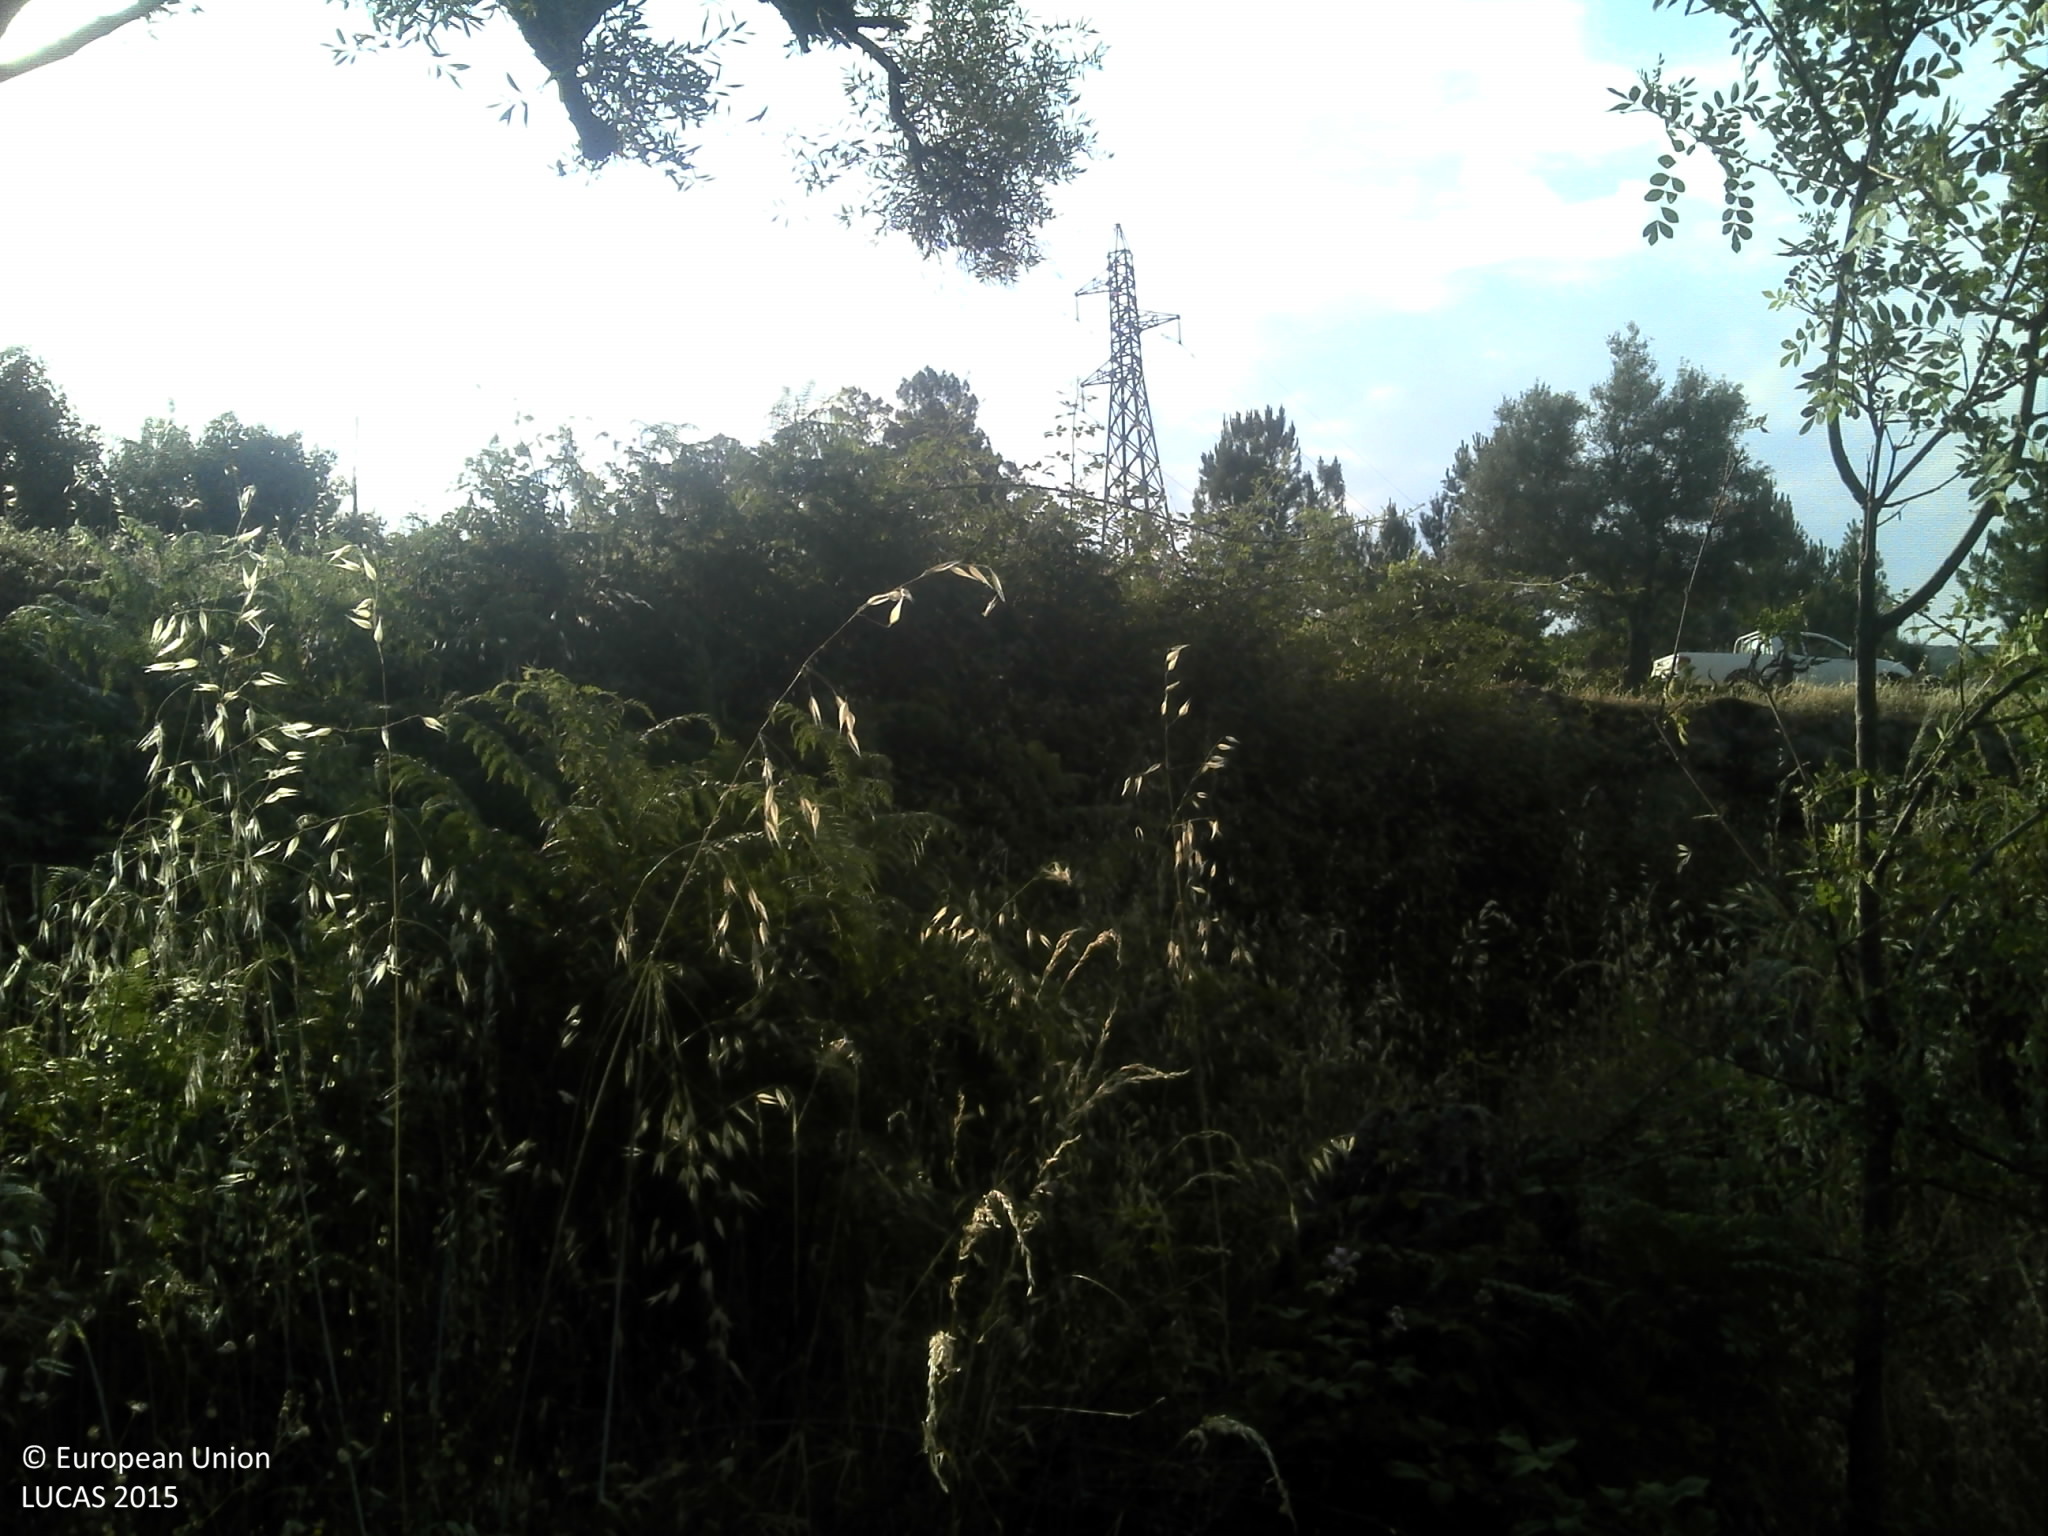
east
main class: Grassland
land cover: Grassland without tree/shrub cover
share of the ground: 50 - 75 %
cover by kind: herbaceous plants 55 %, unconsolidated bare surface 45 %
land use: Agriculture (excluding fallow land and kitchen gardens)
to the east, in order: Shruby margins; Dry stone walls; Grassland without tree/shrub cover; Dry stone walls; Grassland without tree/shrub cover; Dry stone walls; Grassland without tree/shrub cover; Dry stone walls; Grassland without tree/shrub cover; Electric lines; Grassland without tree/shrub cover; Shrubland without tree cover; Dry stone walls; Tracks; Dry stone walls; Shrubland with sparse tree cover; Dry stone walls; Shrubland with sparse tree cover
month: June
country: PT
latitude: 40.3568
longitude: -7.2102
